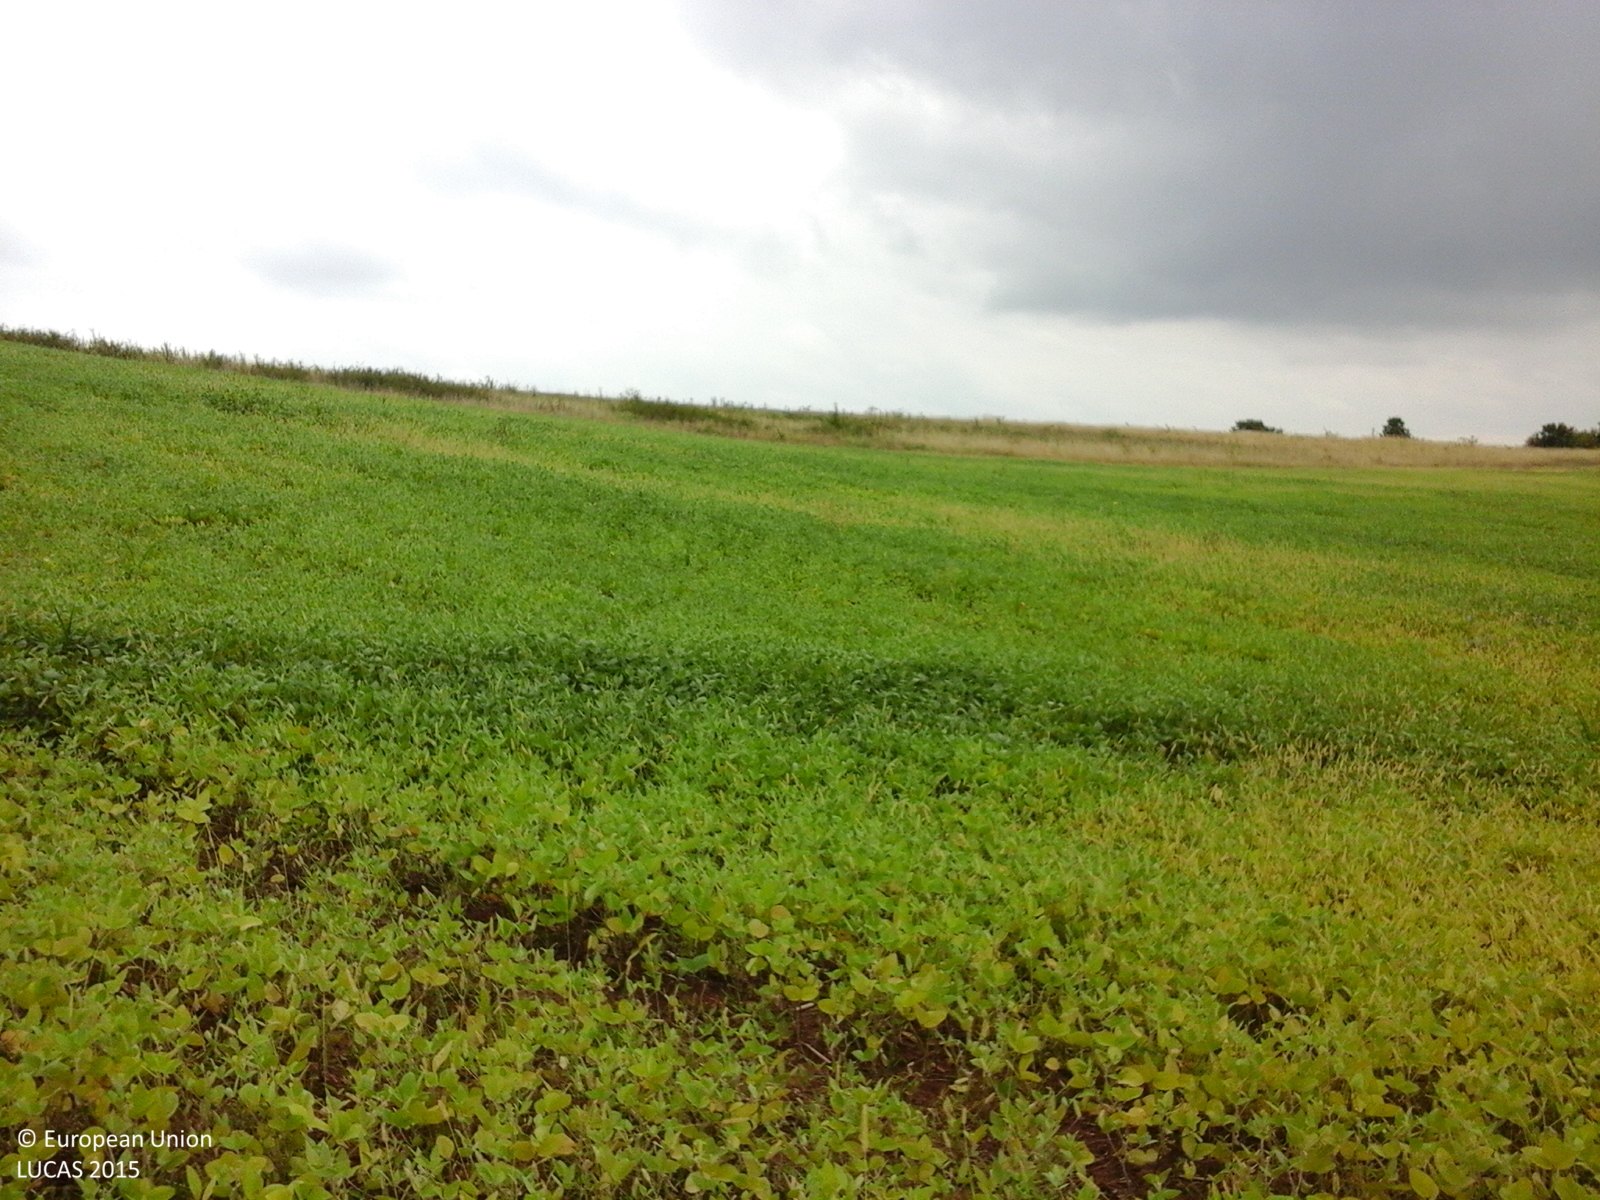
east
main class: Cropland
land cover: Soya
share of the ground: > 75 %
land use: Agriculture (excluding fallow land and kitchen gardens)
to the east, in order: Soya; Grassland with sparse tree/shrub cover; Tracks; Grassland without tree/shrub cover
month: August
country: RO
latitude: 45.5725
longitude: 21.7608
